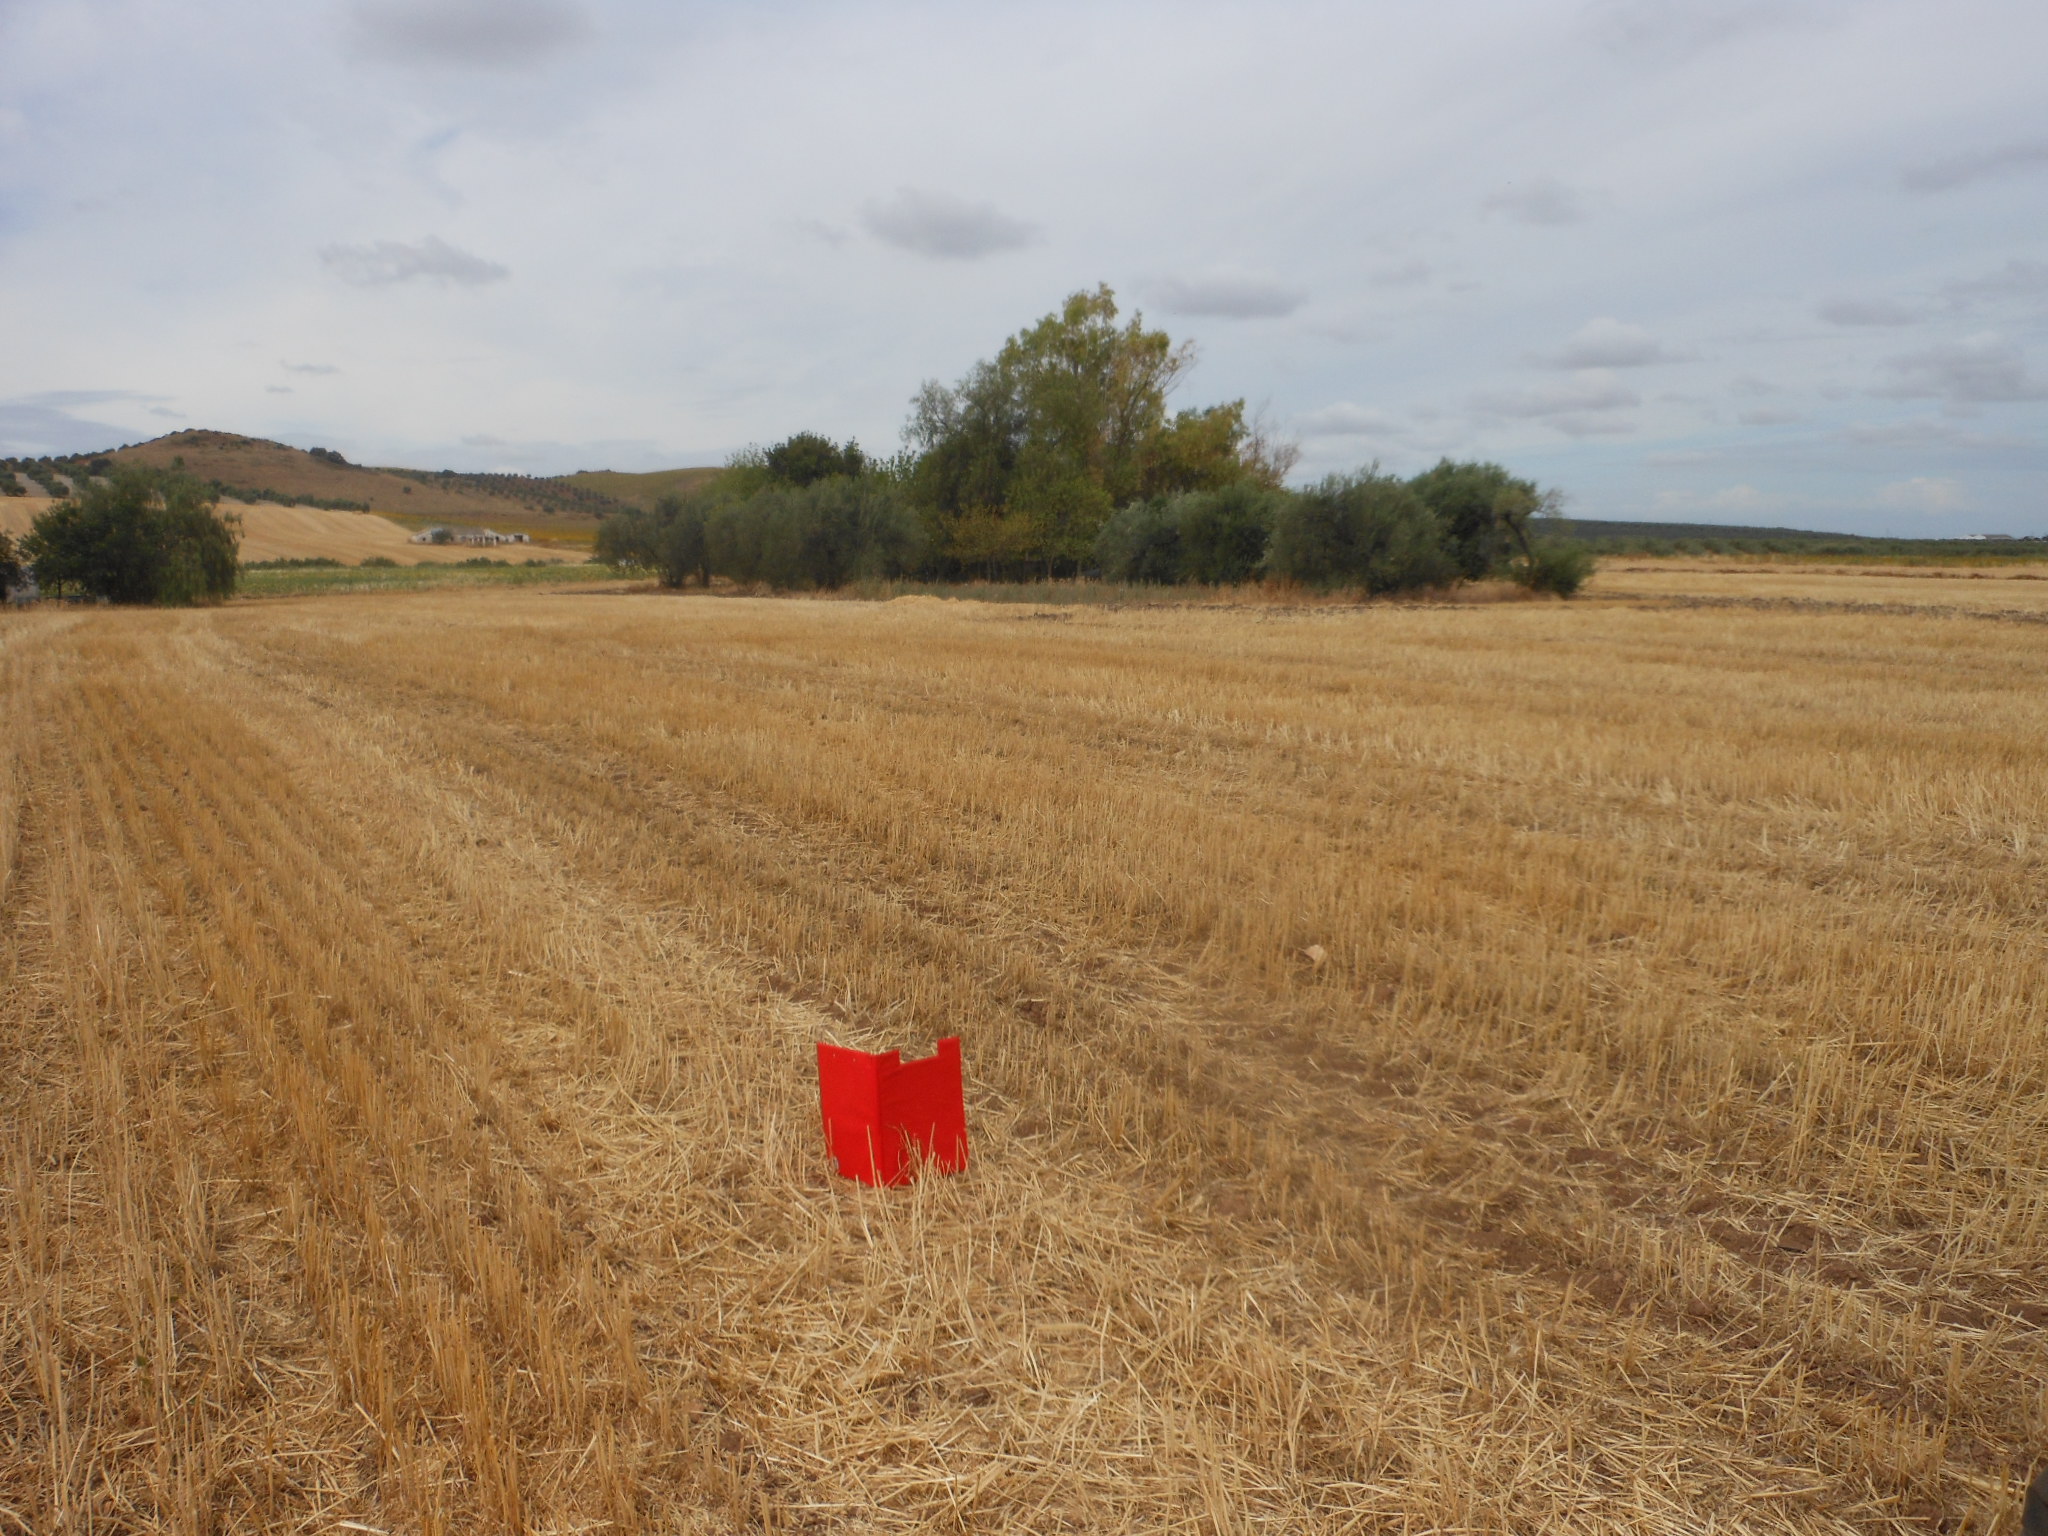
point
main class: Cropland
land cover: Common wheat
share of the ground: < 10 %
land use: Agriculture (excluding fallow land and kitchen gardens)
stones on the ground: < 10 %
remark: Harvested field
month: June
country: ES
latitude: 37.1620
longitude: -5.4269
